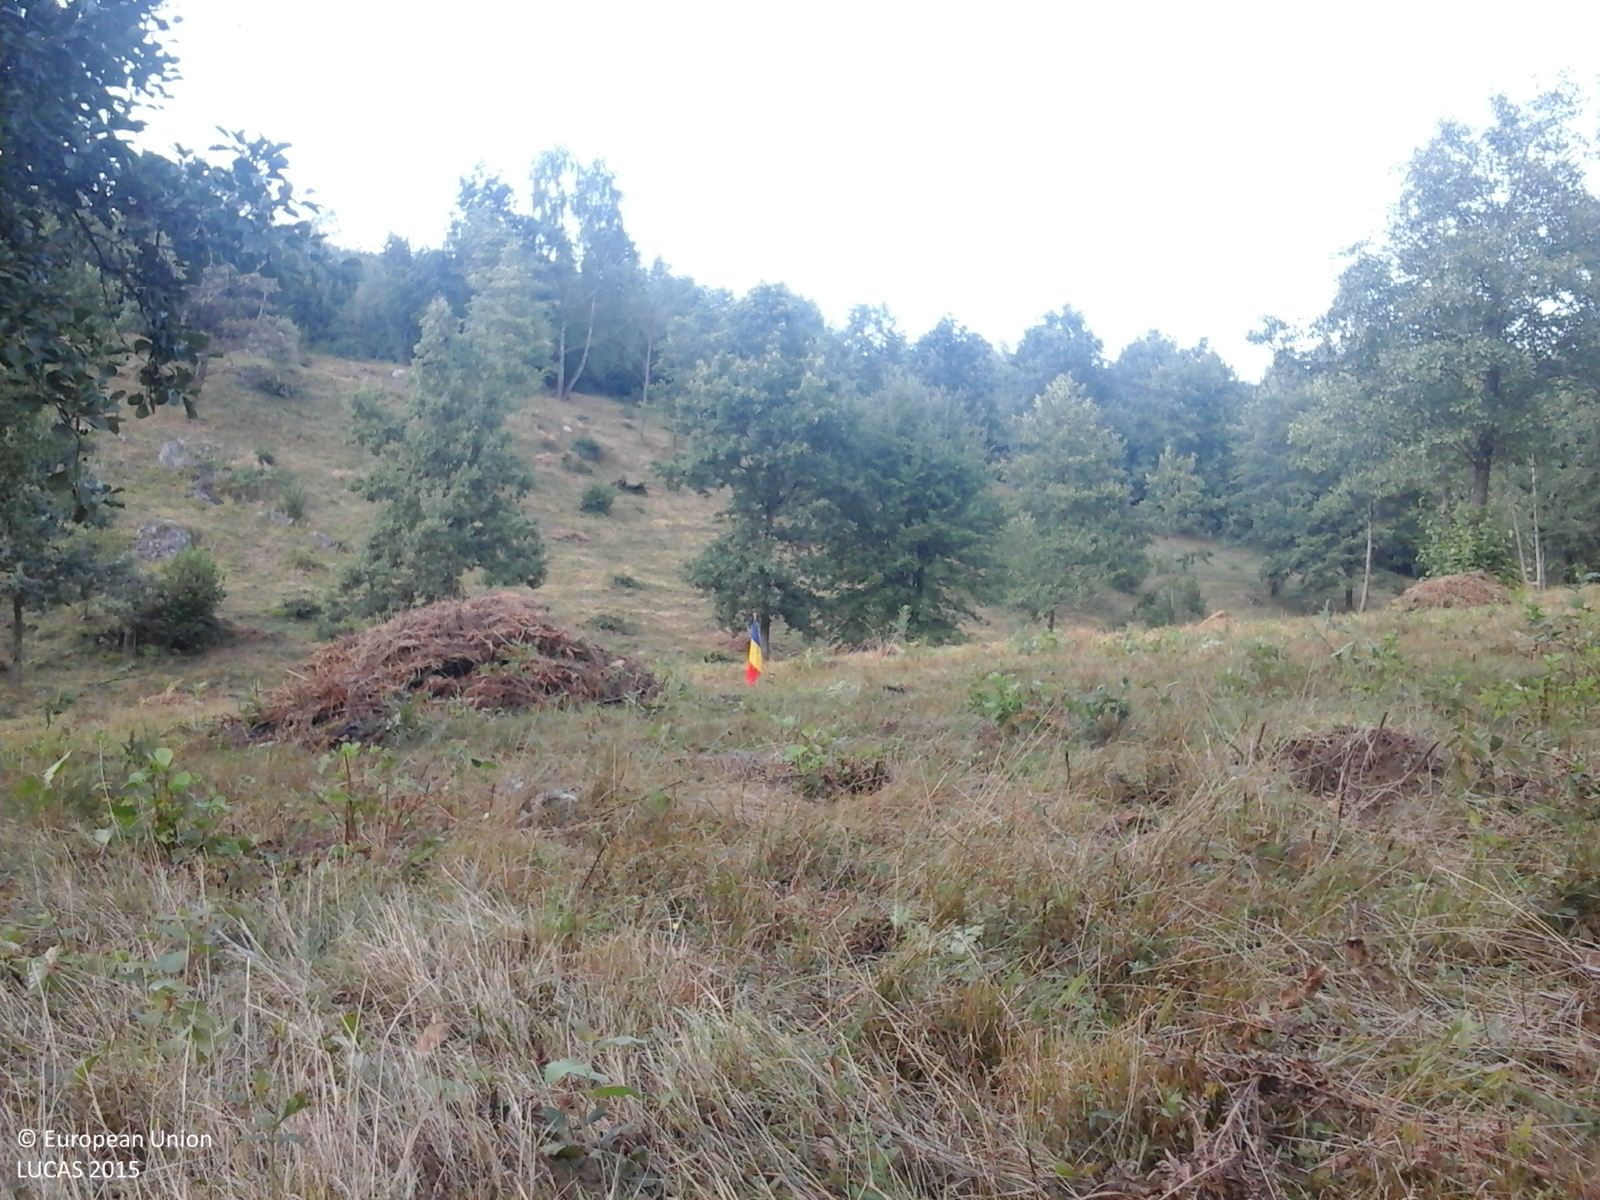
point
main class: Grassland
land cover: Grassland with sparse tree/shrub cover
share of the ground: > 75 %
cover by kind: herbaceous plants 85 %, shrubs 10 %, broadleaved forest trees 5 %
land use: Agriculture (excluding fallow land and kitchen gardens)
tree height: > 5 m
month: September
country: RO
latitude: 47.7831
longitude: 23.8425
